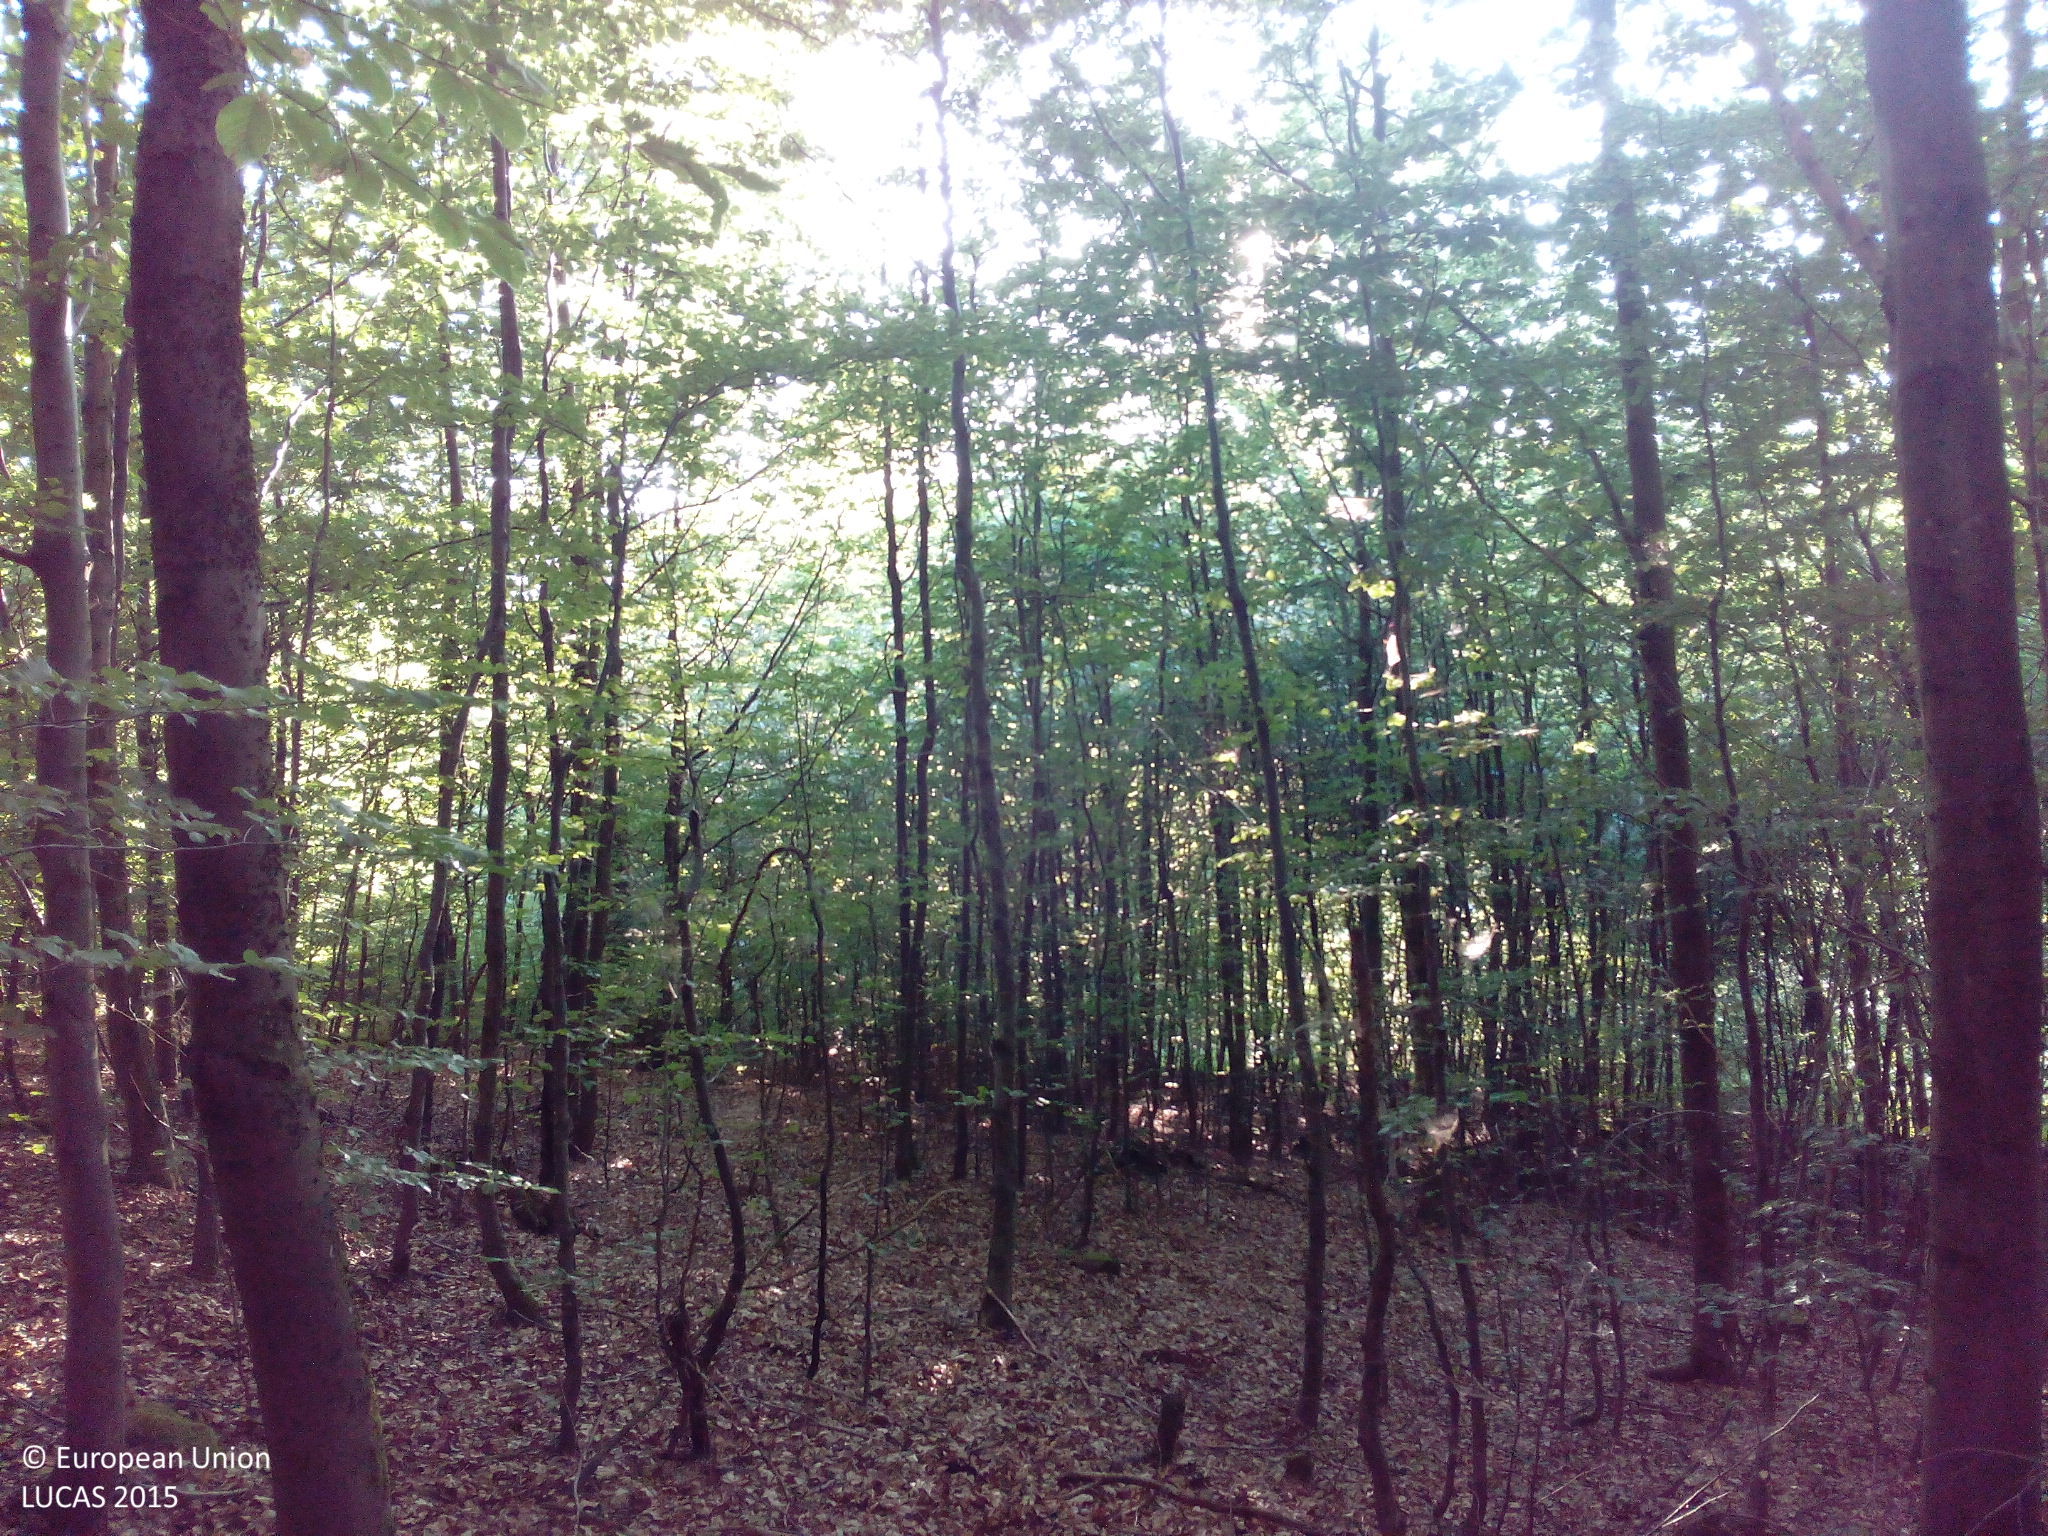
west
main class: Woodland
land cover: Broadleaved woodland
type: beech forest
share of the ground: > 75 %
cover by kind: broadleaved forest trees 90 %, unconsolidated bare surface 10 %
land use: Forestry
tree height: > 5 m
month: July
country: DE
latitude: 49.1514
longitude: 7.6012
